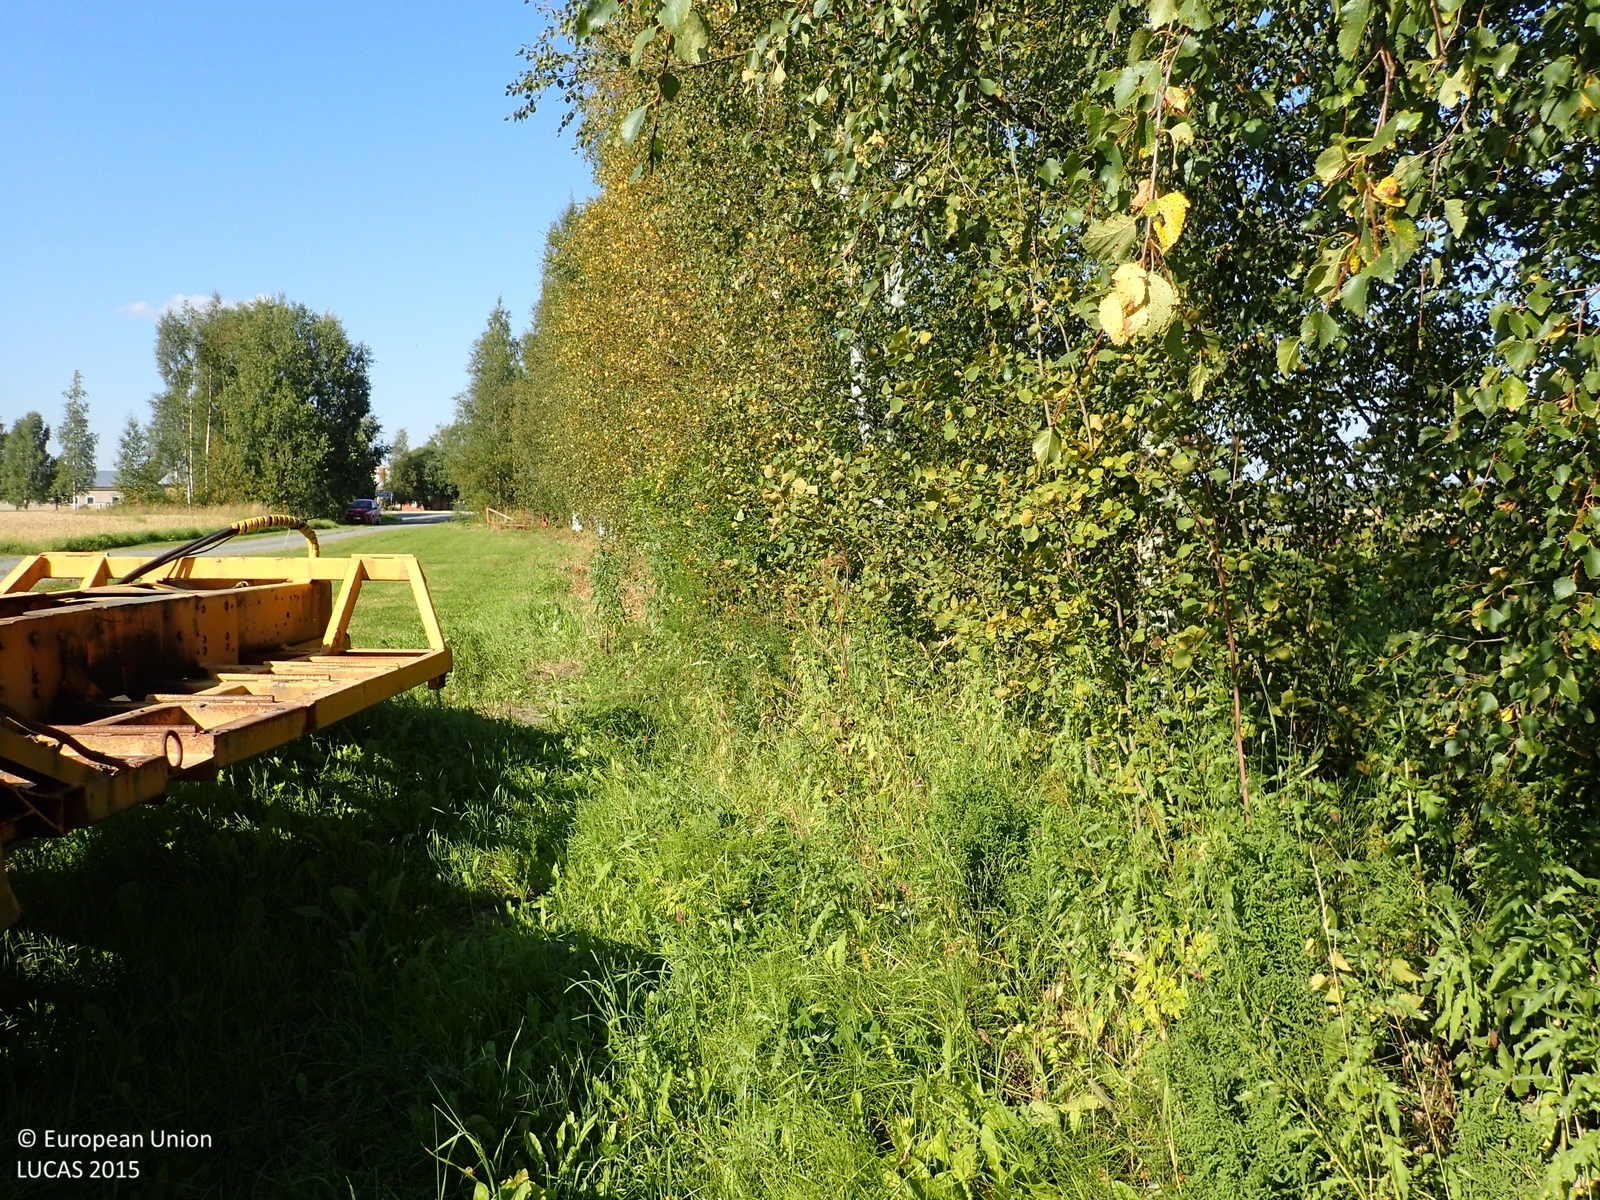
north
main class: Woodland
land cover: Broadleaved woodland
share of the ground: 25 - 50 %
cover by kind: herbaceous plants 60 %, broadleaved forest trees 40 %
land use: Residential
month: August
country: FI
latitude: 62.5123
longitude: 21.7961
